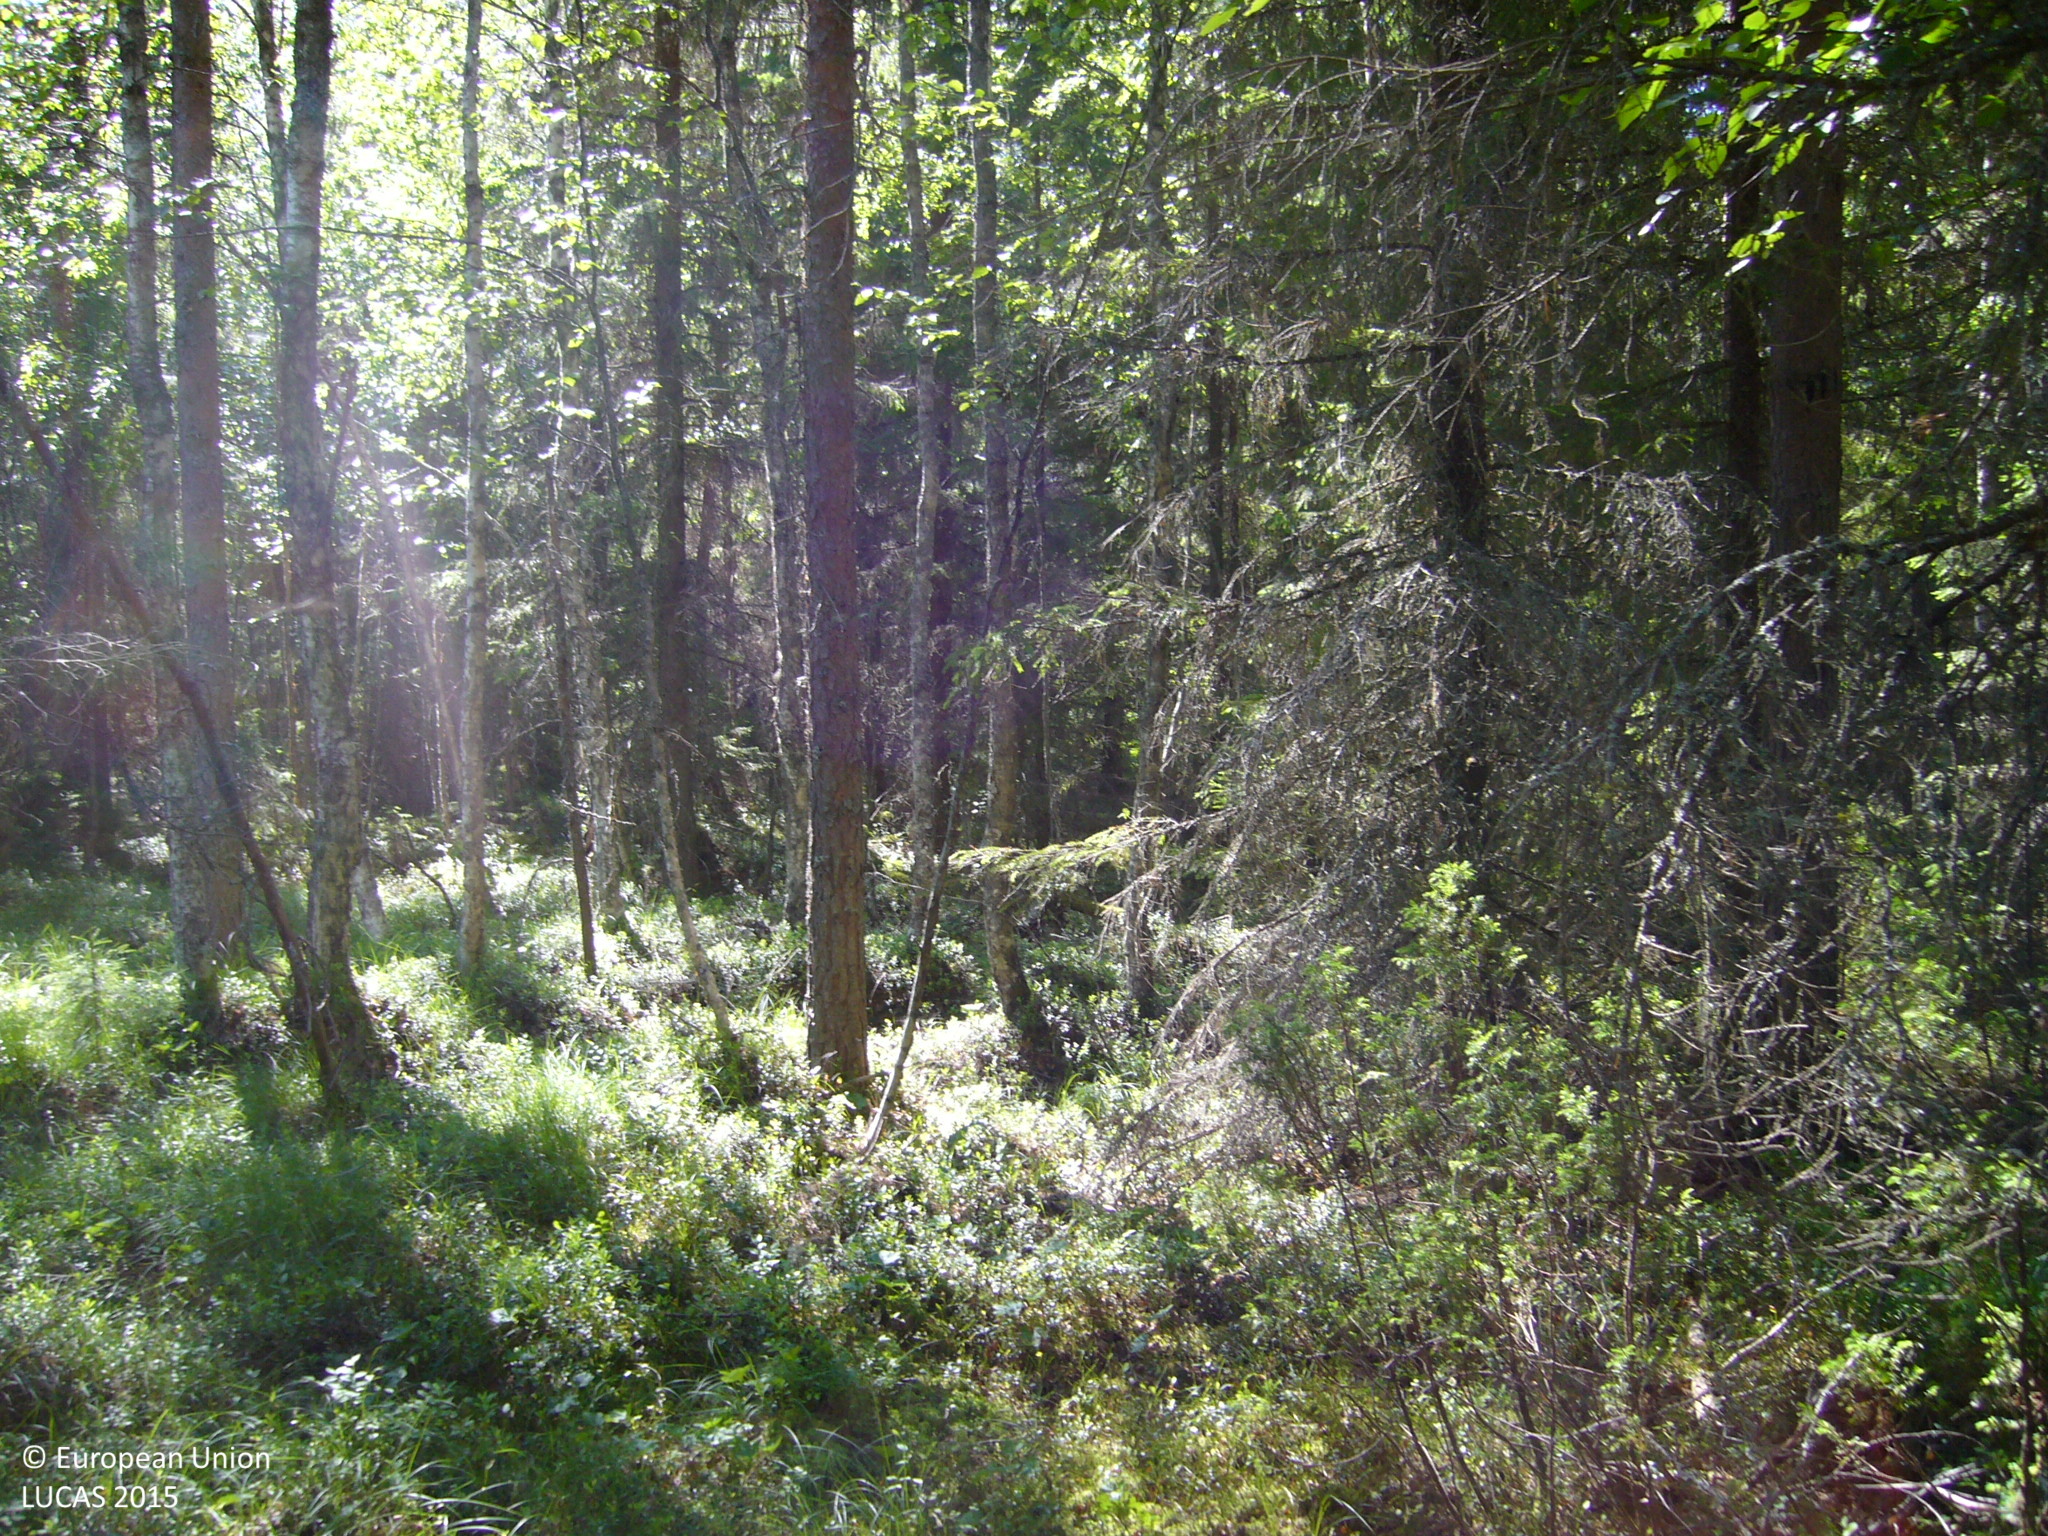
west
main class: Woodland
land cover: Spruce dominated mixed woodland
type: boreal forest
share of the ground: > 75 %
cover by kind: coniferous forest trees 60 %, broadleaved forest trees 25 %, shrubs 15 %
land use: Forestry
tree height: > 5 m
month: July
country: FI
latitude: 63.3732
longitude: 26.0147
